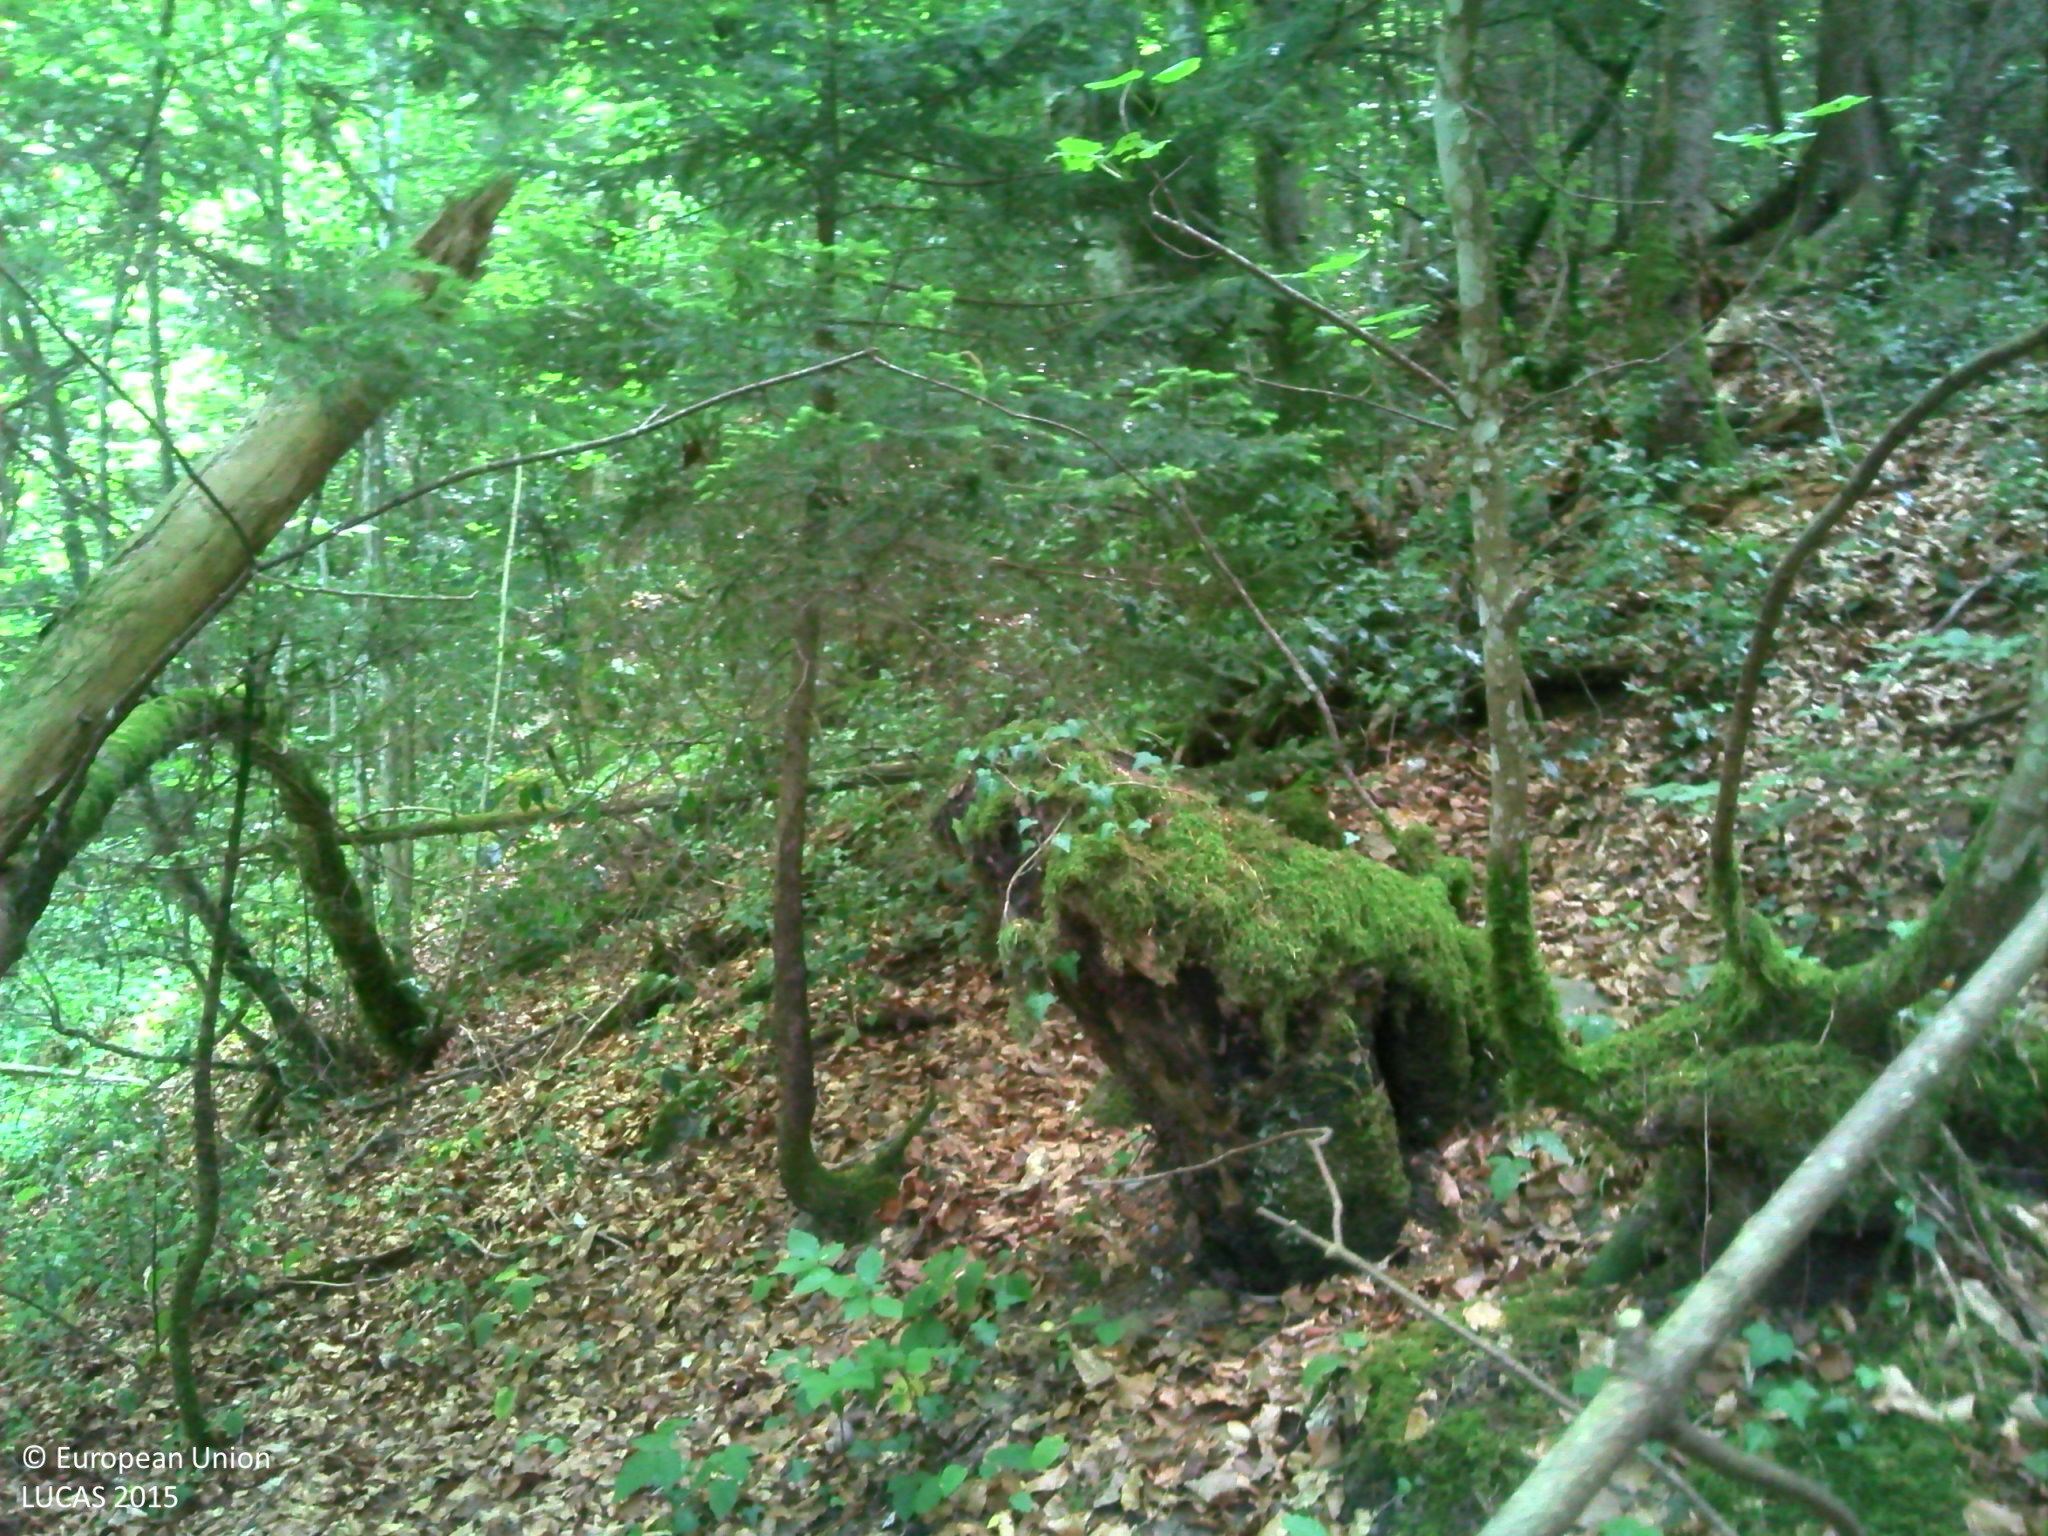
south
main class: Woodland
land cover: Spruce dominated coniferous woodland
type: alpine coniferous forest
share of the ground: > 75 %
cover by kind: coniferous forest trees 60 %, herbaceous plants 20 %, broadleaved forest trees 15 %, lichens and mosses 5 %
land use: Forestry
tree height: > 5 m
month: July
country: FR
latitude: 45.7611
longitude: 6.2113
